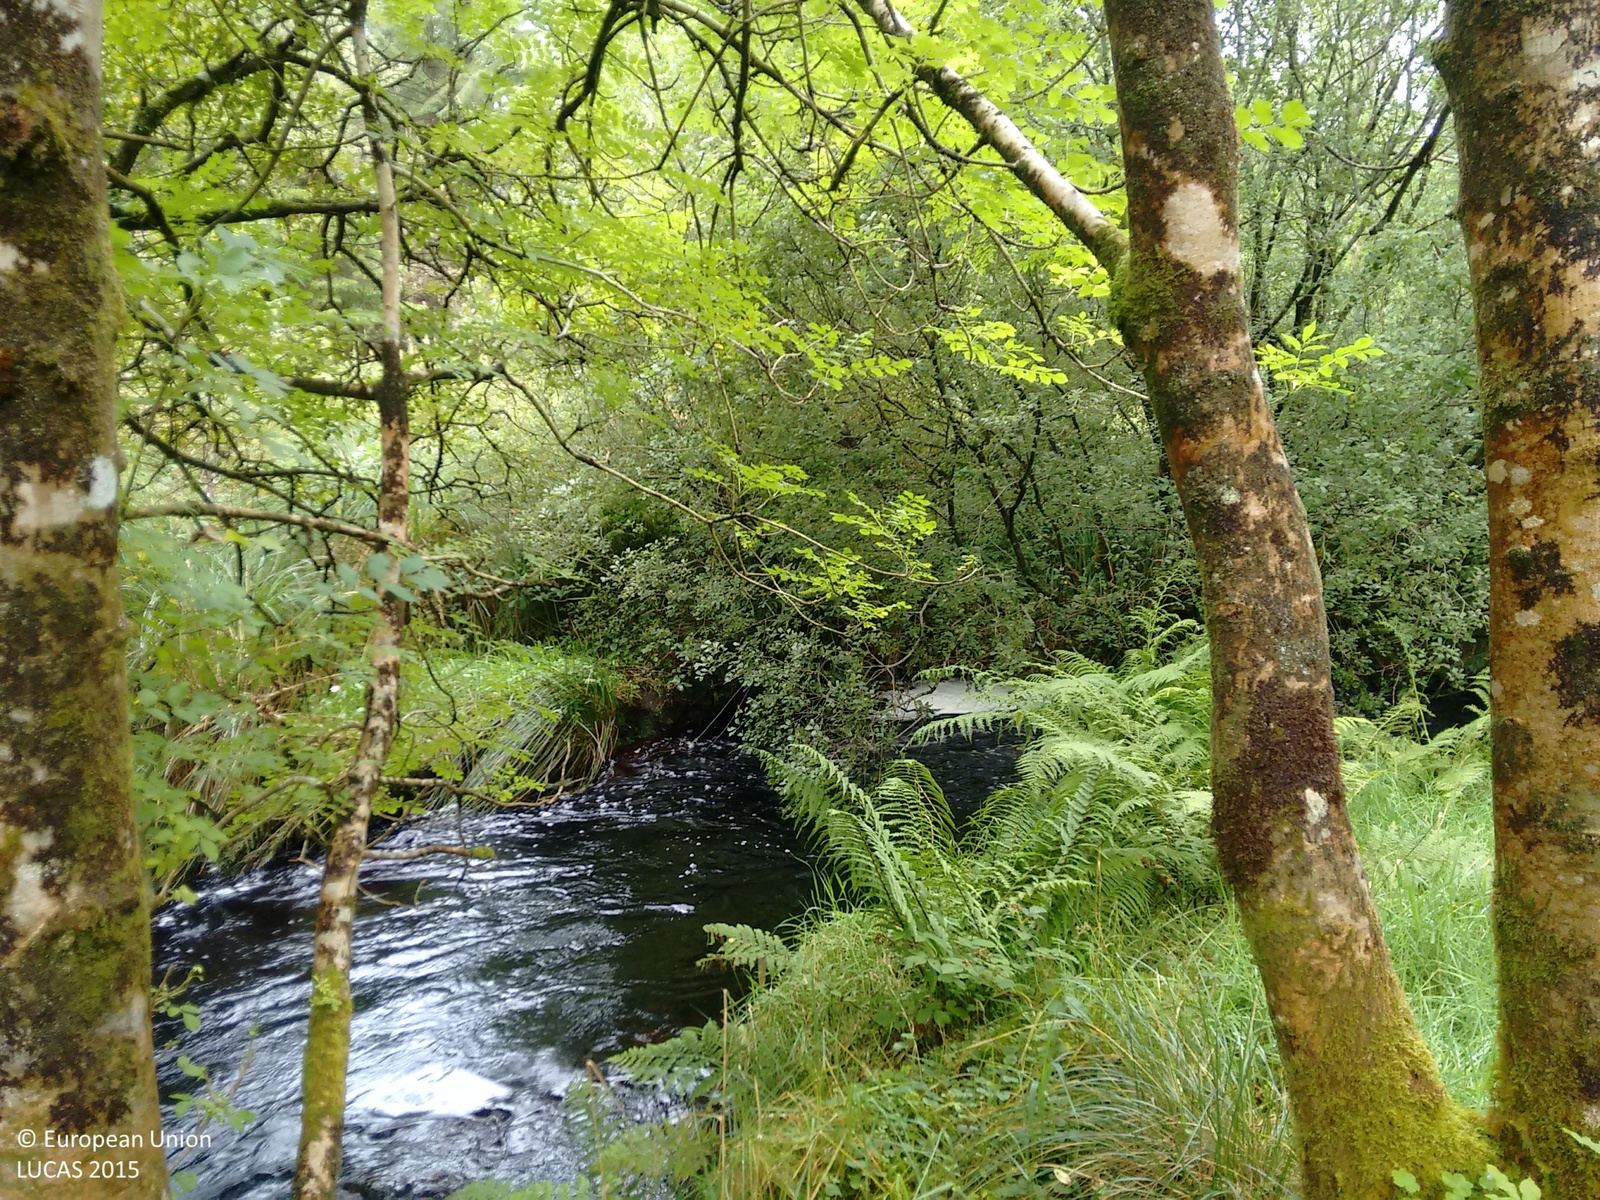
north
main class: Shrubland
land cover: Shrubland with sparse tree cover
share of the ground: > 75 %
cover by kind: shrubs 80 %, herbaceous plants 15 %, coniferous forest trees 5 %
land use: Forestry
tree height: < 5 m
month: September
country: IE
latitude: 52.9288
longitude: -8.7848
